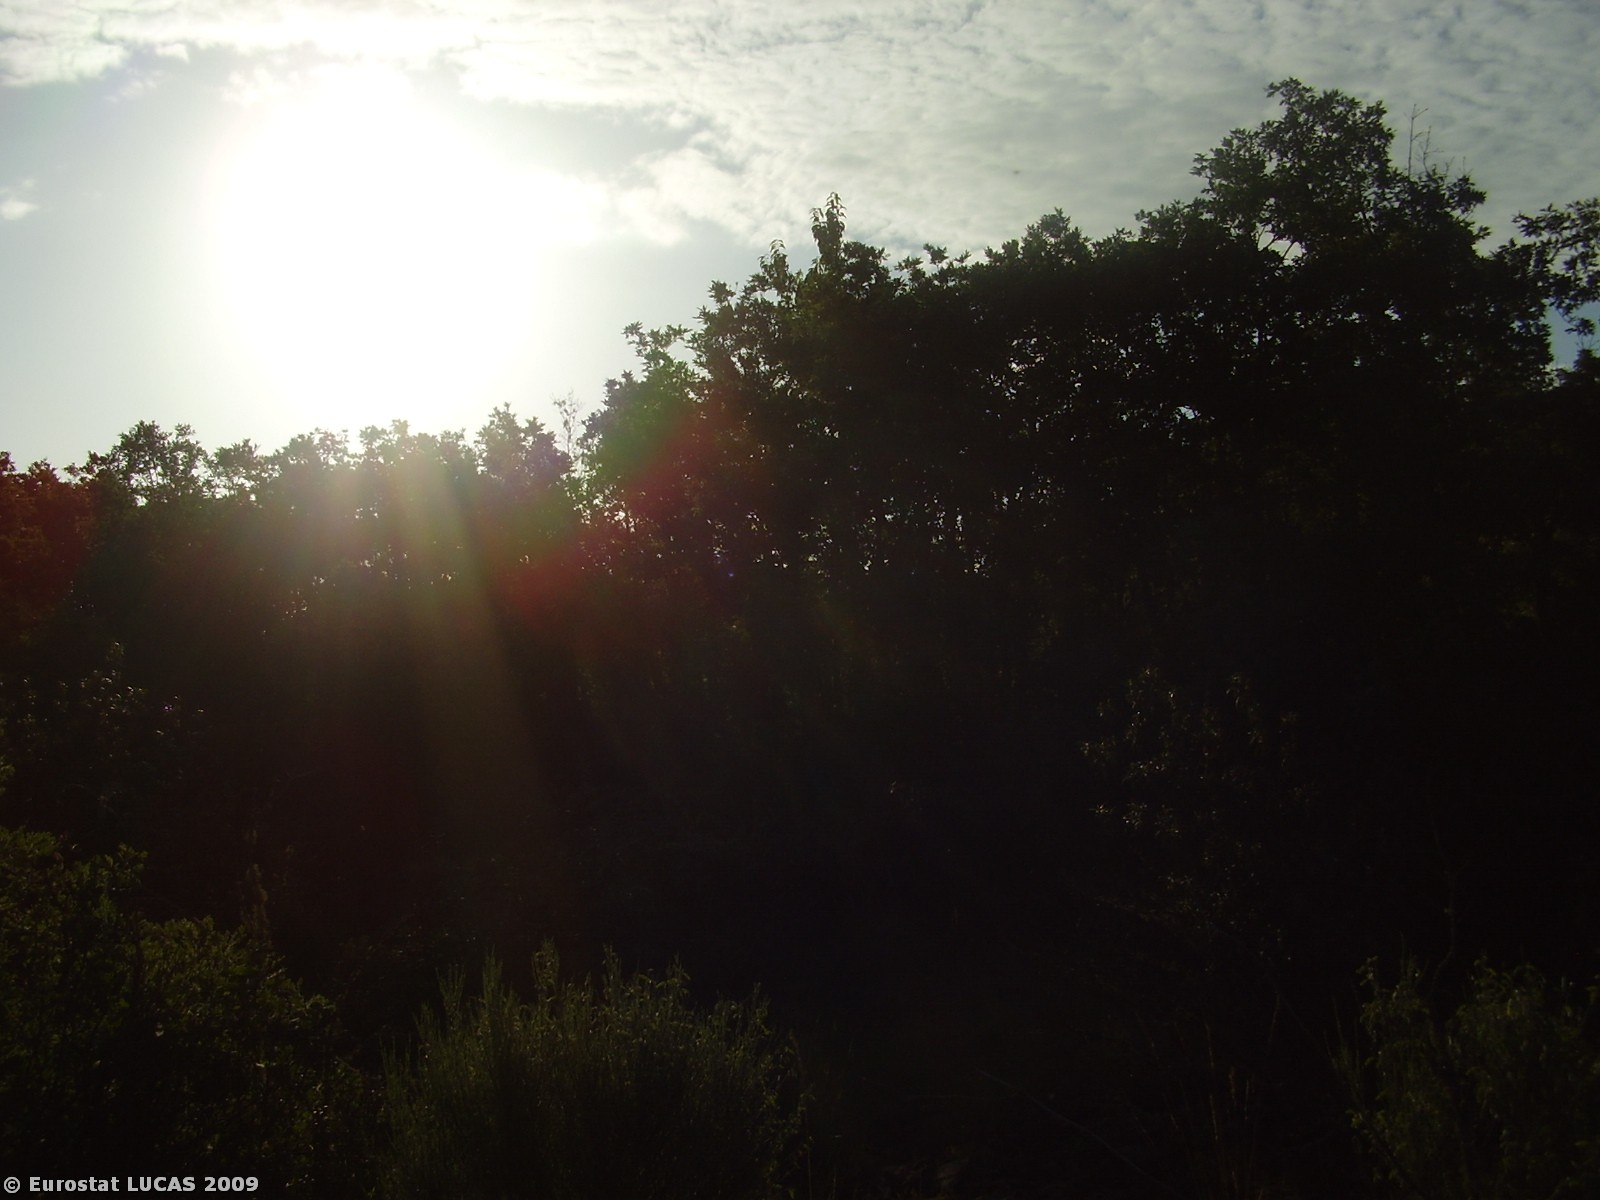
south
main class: Woodland
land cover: Broadleaved woodland
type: thermophilous deciduous forest
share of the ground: > 75 %
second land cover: Spontaneously vegetated surfaces
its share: 10 - 25 %
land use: Nature reserves
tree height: > 5 m
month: June
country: PT
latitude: 41.8176
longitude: -6.8614
